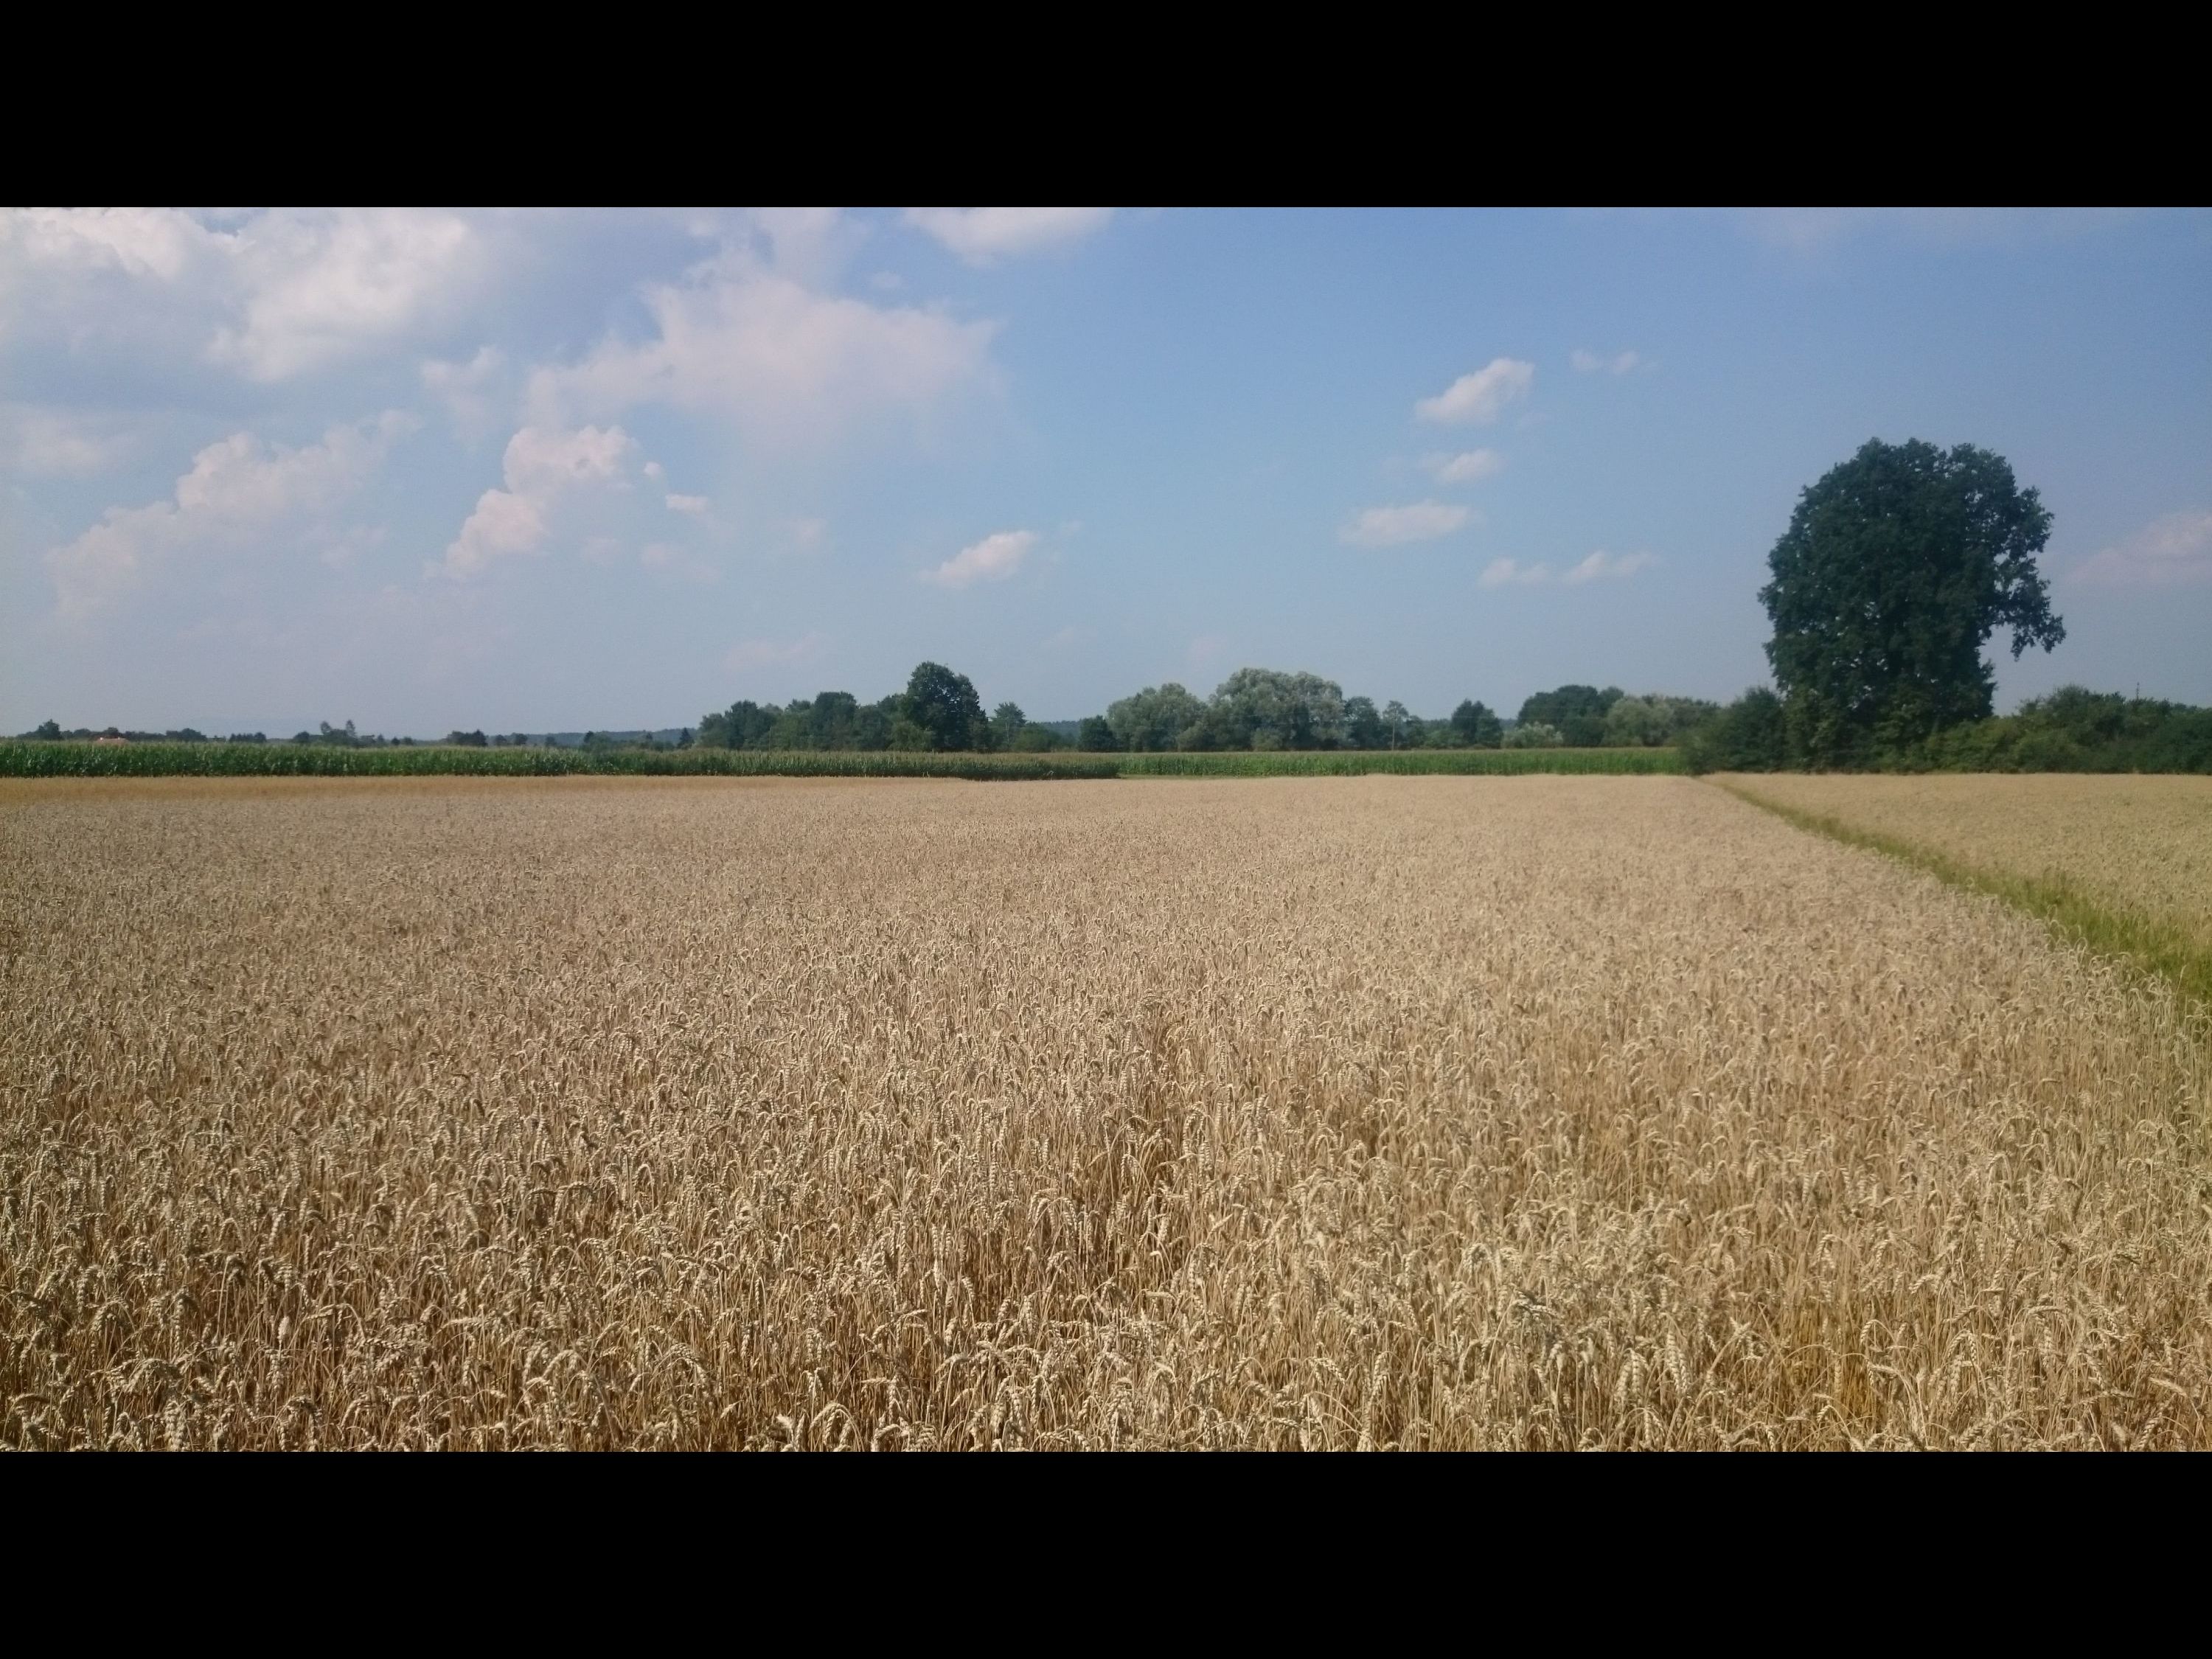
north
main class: Cropland
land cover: Maize
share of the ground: > 75 %
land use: Agriculture (excluding fallow land and kitchen gardens)
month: July
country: AT
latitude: 47.0679
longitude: 15.9925
